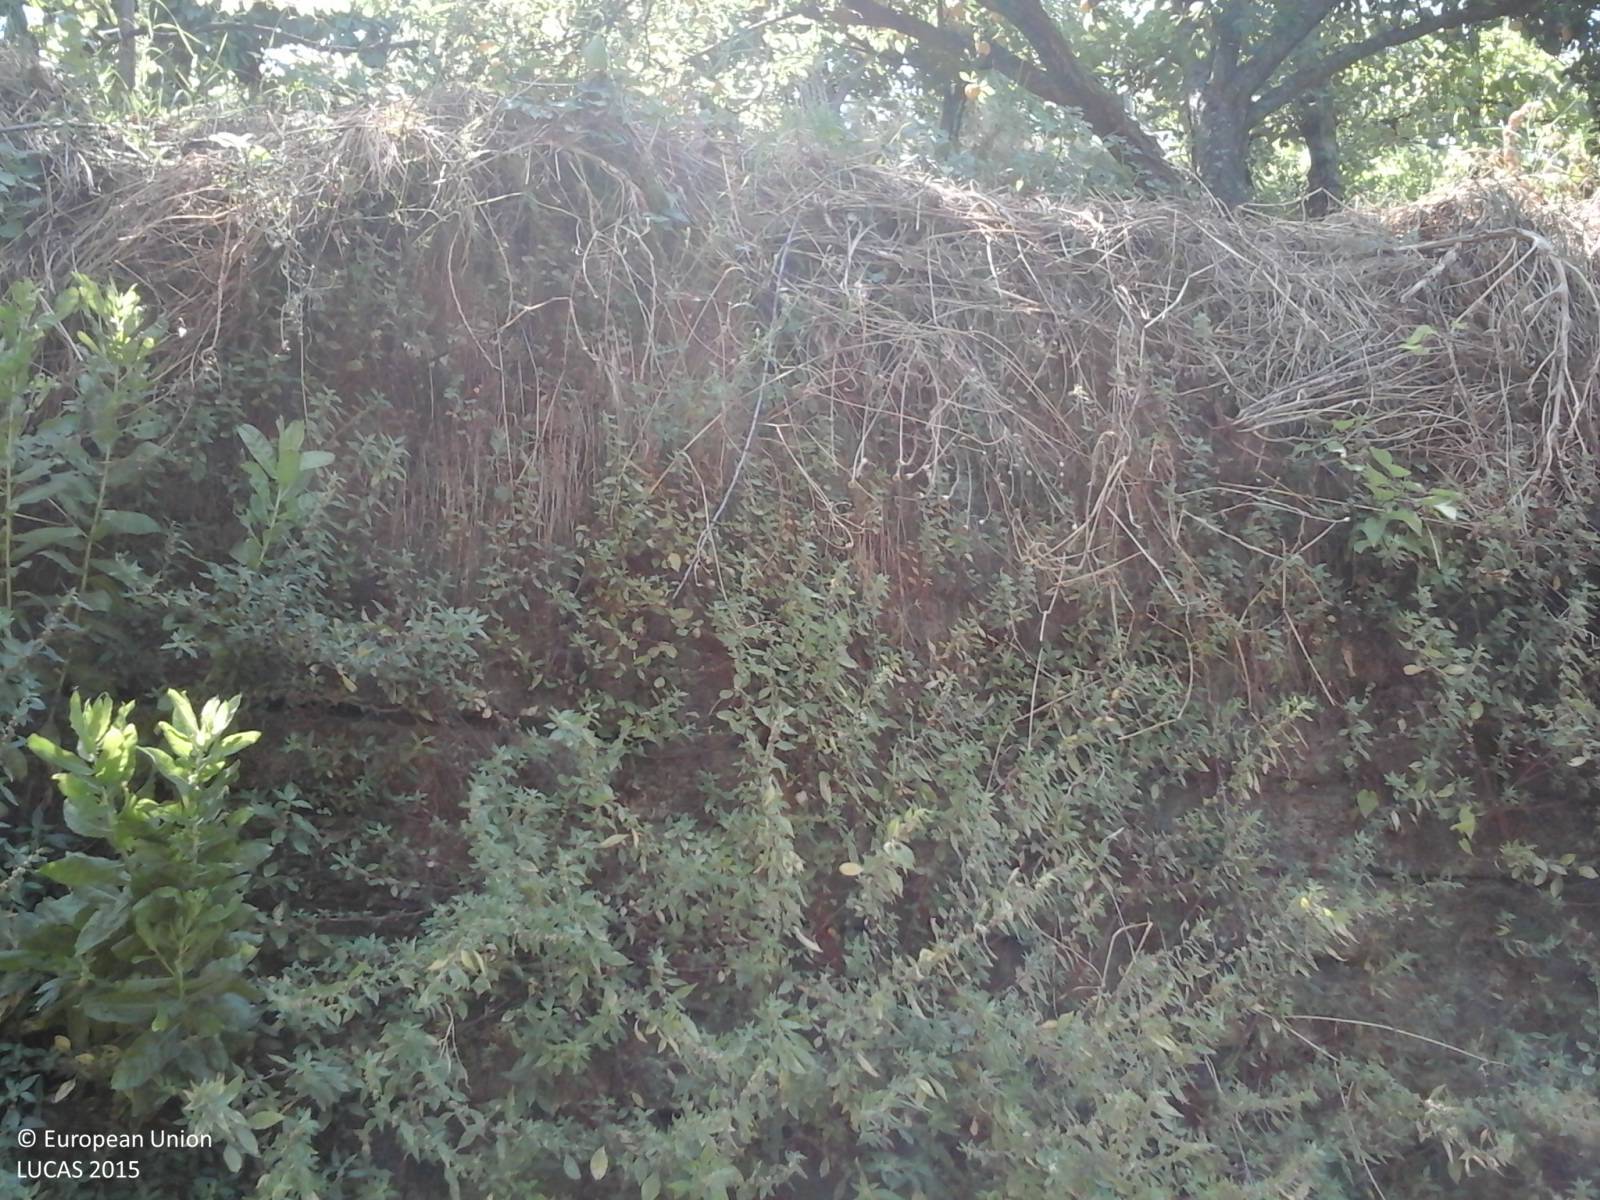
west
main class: Cropland
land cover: Other fruit trees and berries
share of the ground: > 75 %
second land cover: Spontaneously vegetated surfaces
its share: > 75 %
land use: Agriculture (excluding fallow land and kitchen gardens)
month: June
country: IT
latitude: 40.8641
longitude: 14.2415
